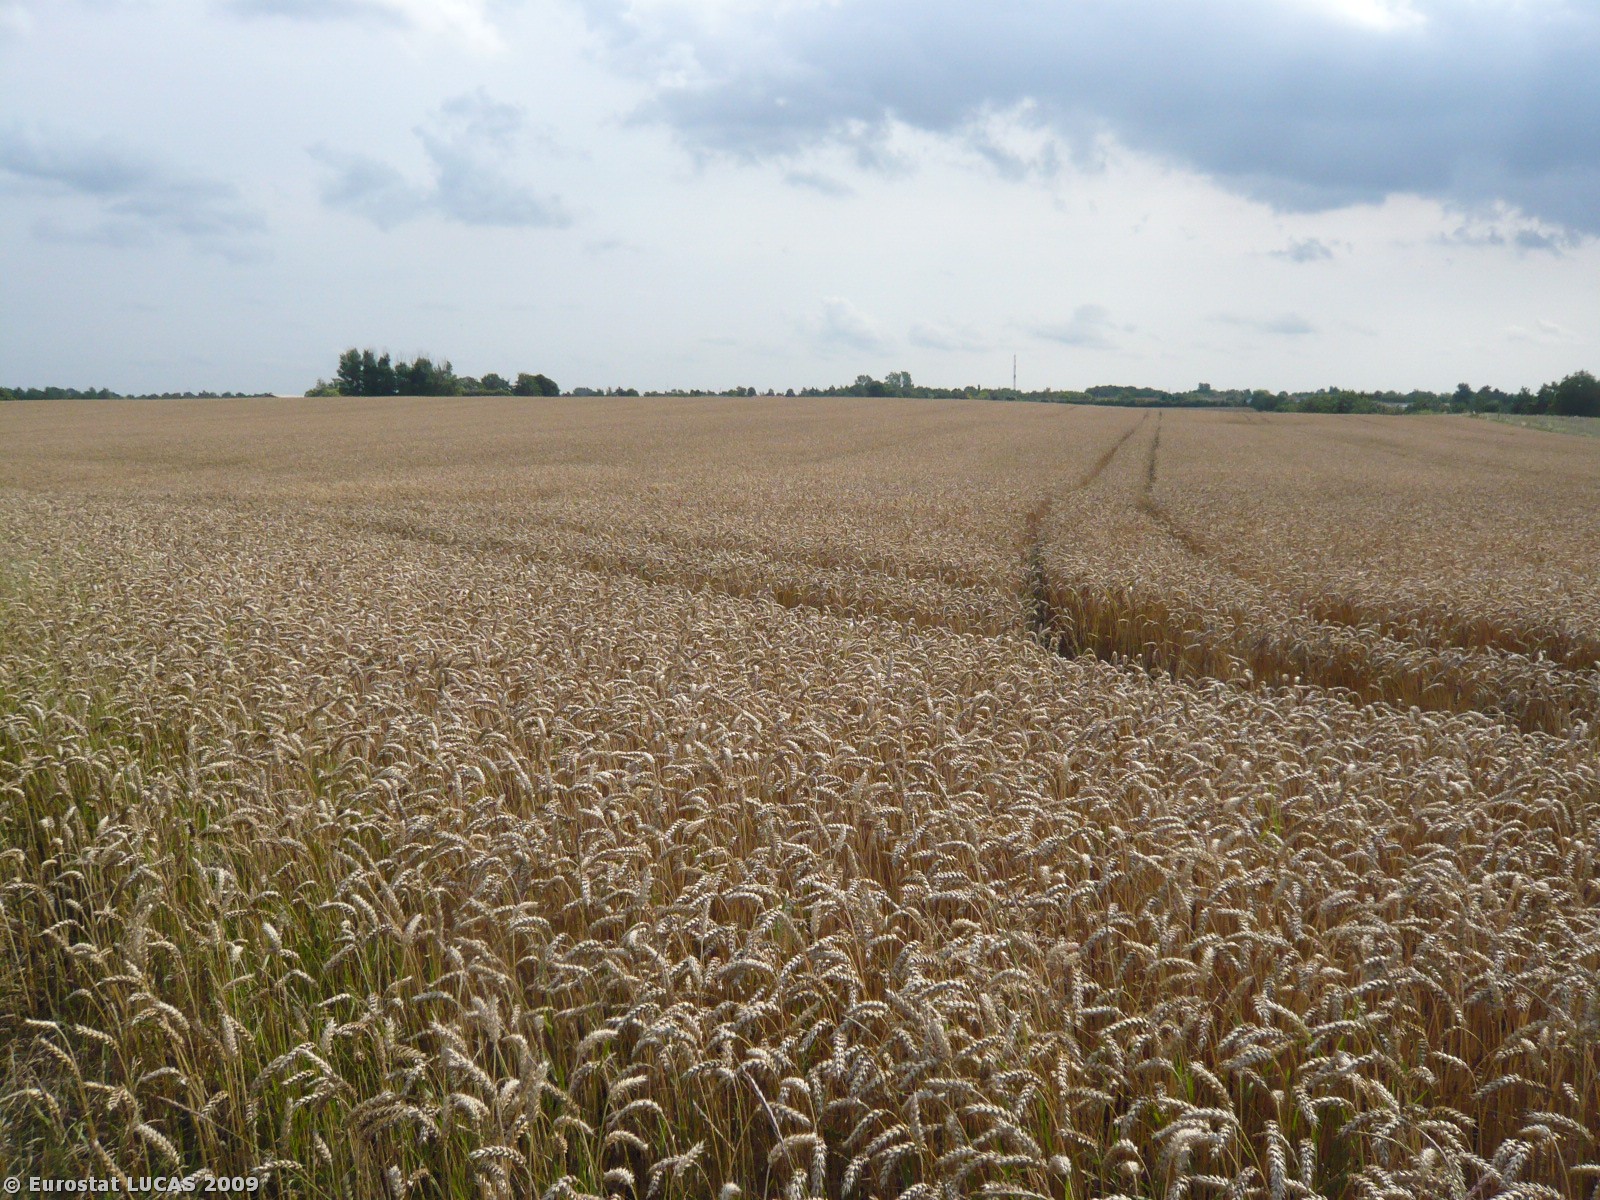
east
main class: Cropland
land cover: Common wheat
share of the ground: > 75 %
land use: Agriculture (excluding fallow land and kitchen gardens)
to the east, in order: Common wheat
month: July
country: DK
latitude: 55.7741
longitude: 12.1502
